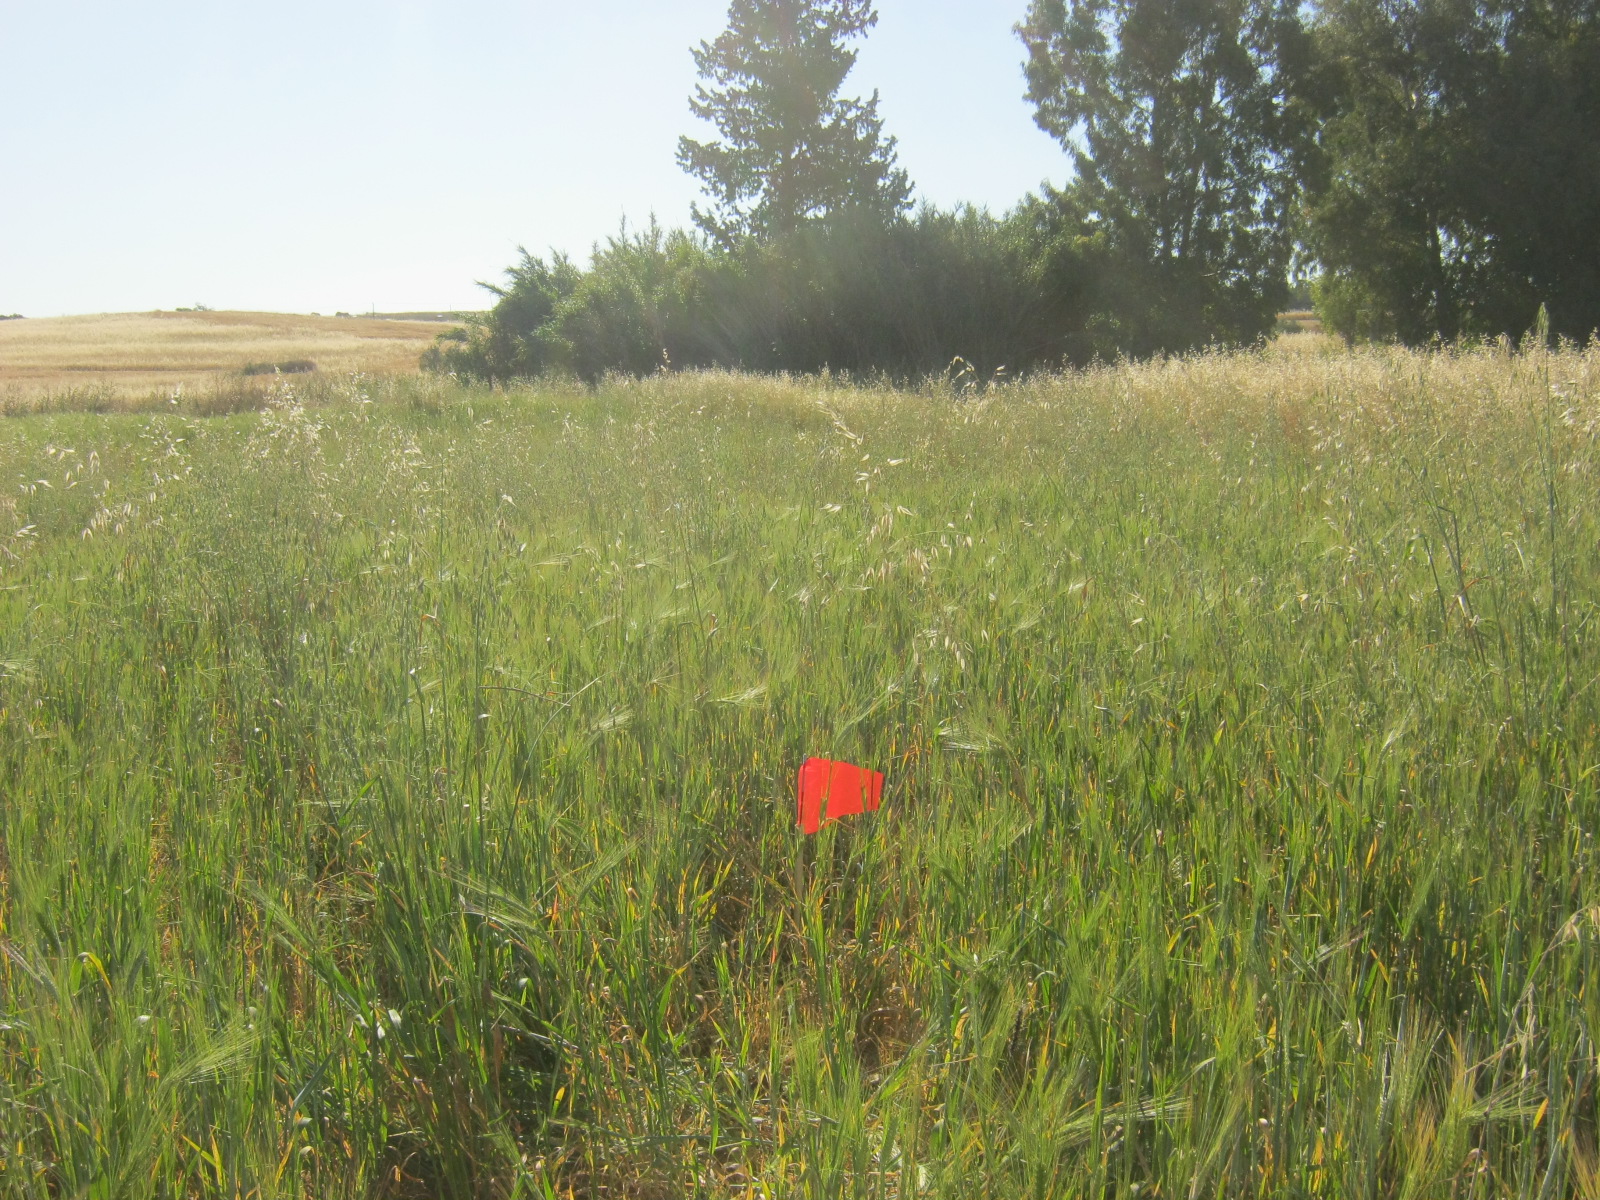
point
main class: Cropland
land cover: Common wheat
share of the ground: > 75 %
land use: Agriculture (excluding fallow land and kitchen gardens)
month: May
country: CY
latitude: 35.1428
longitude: 33.2488
